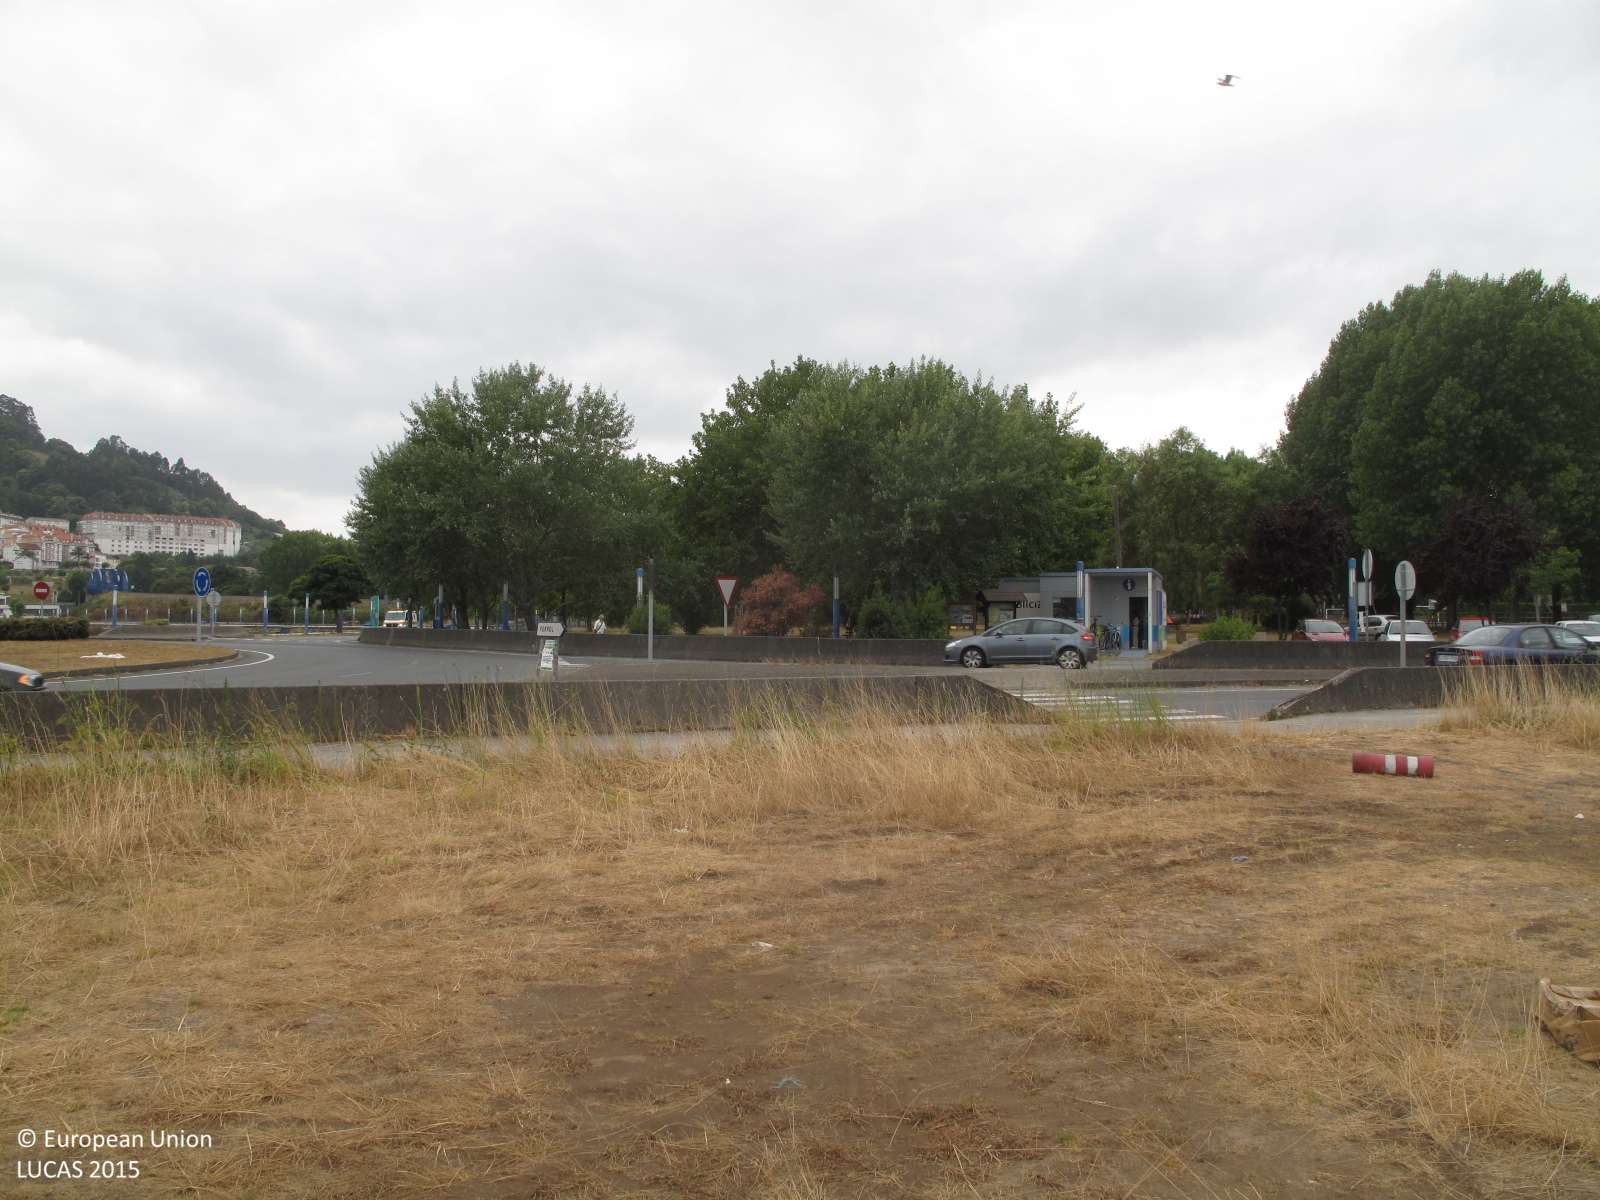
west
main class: Grassland
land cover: Spontaneously vegetated surfaces
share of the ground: 10 - 25 %
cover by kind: unconsolidated bare surface 80 %, herbaceous plants 20 %
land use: Abandoned areas
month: July
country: ES
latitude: 43.4129
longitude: -8.1678
